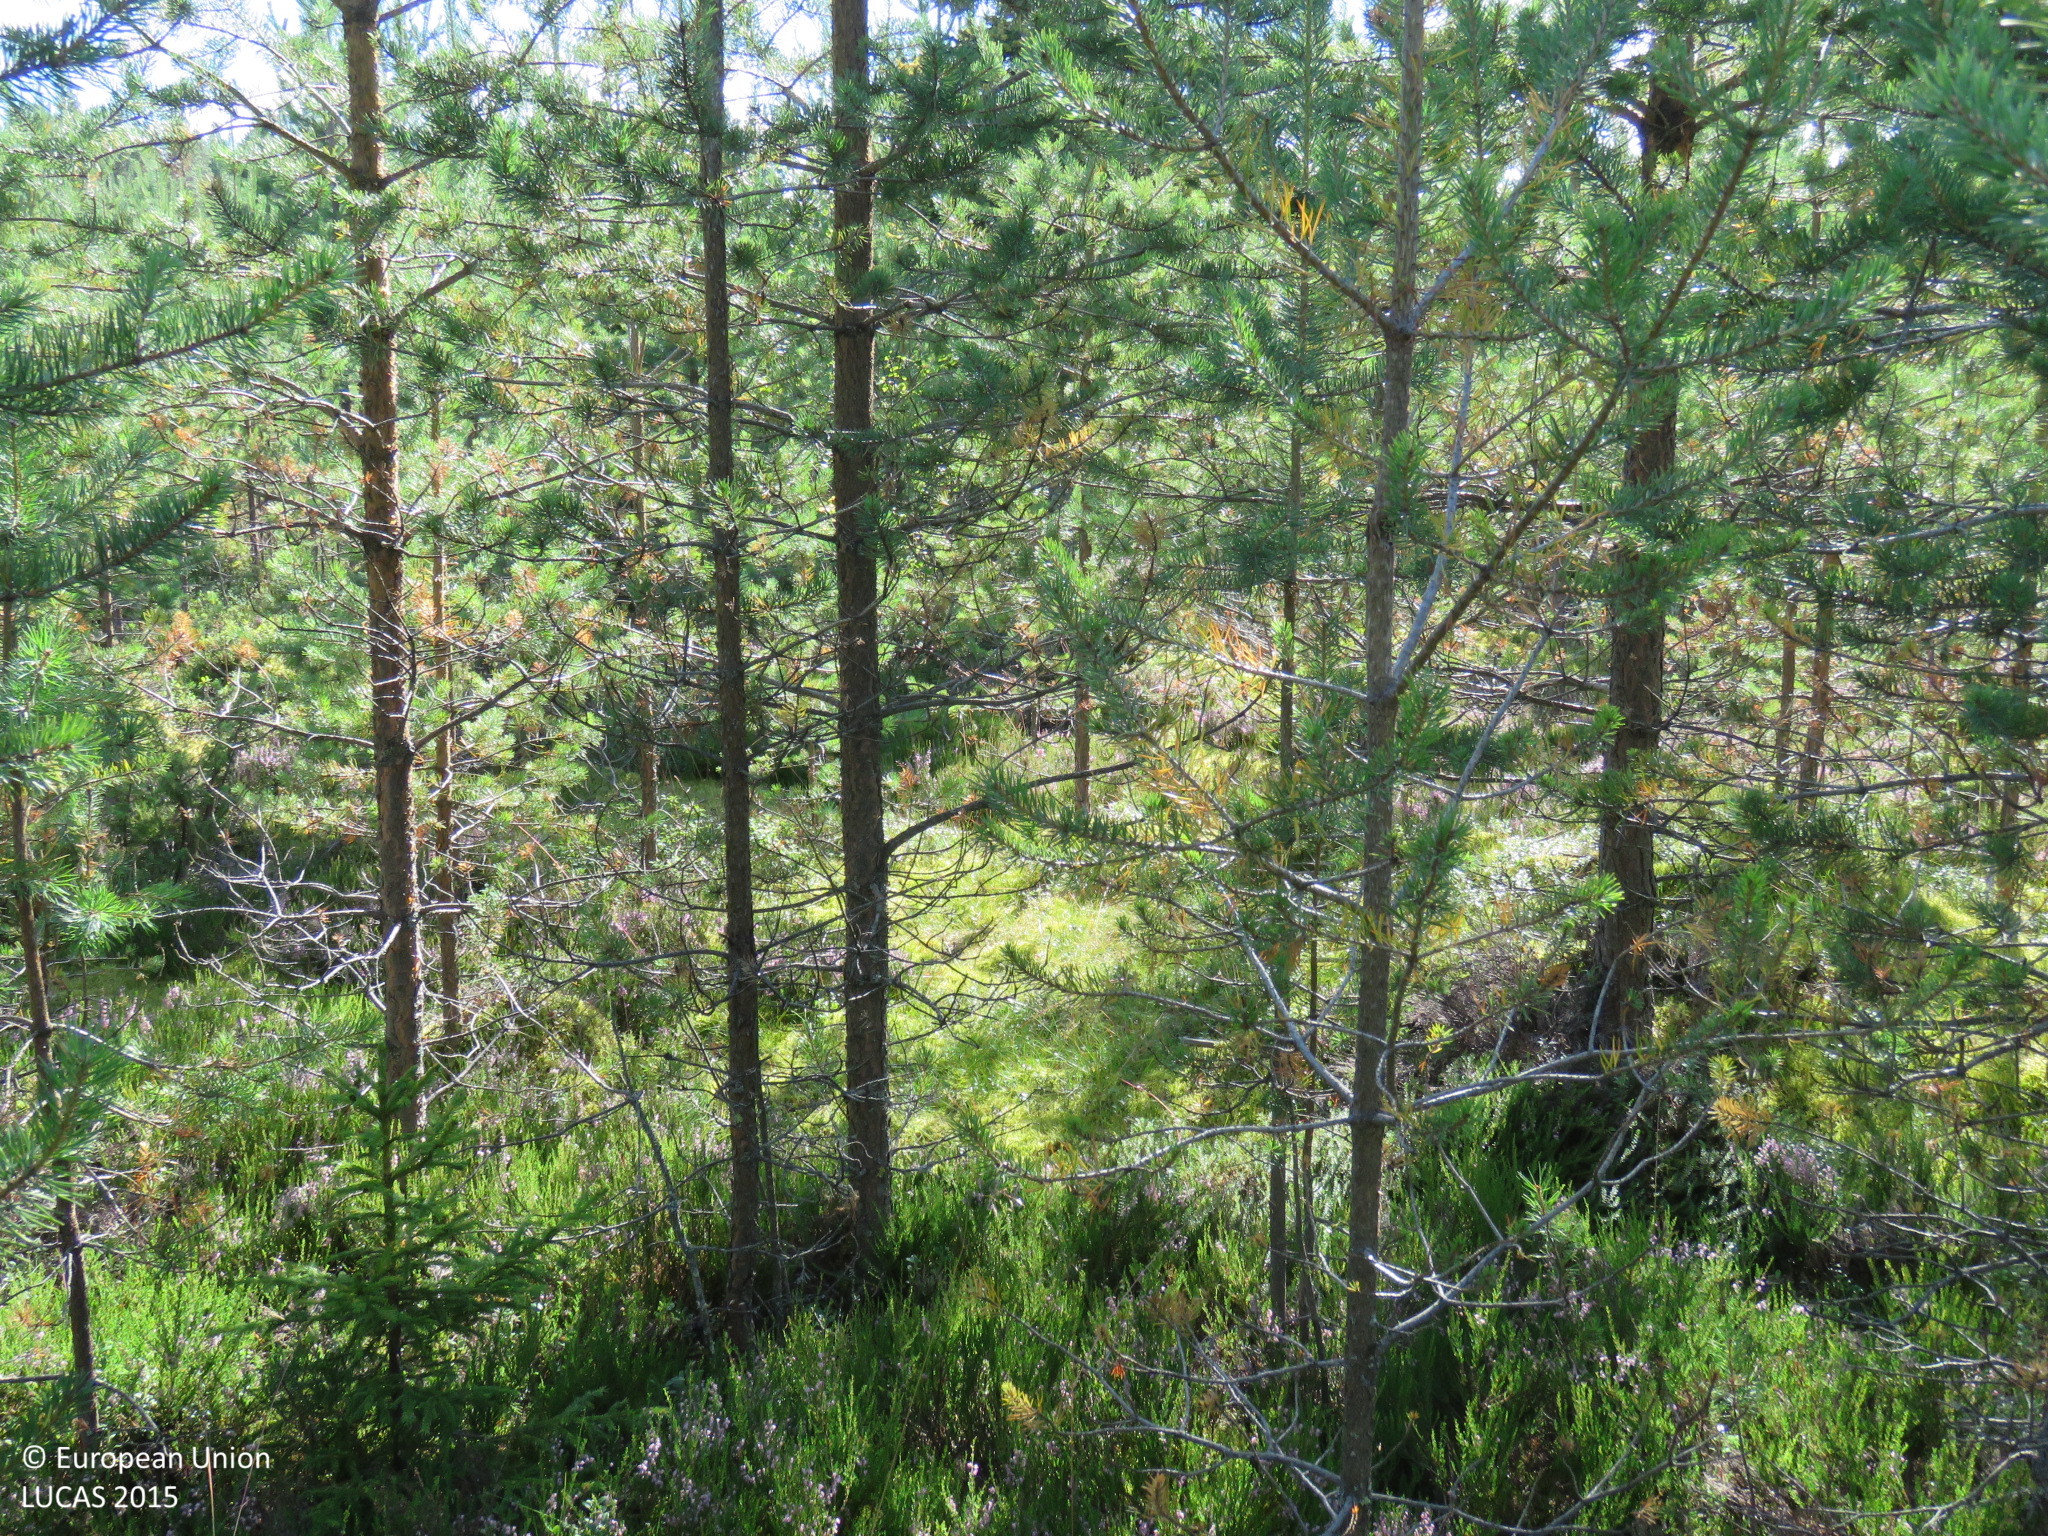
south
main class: Woodland
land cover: Pine dominated coniferous woodland
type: boreal forest
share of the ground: > 75 %
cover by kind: coniferous forest trees 85 %, shrubs 10 %, broadleaved forest trees 5 %
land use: Forestry
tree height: < 5 m
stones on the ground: < 10 %
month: August
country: FI
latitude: 65.1574
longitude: 25.7671
